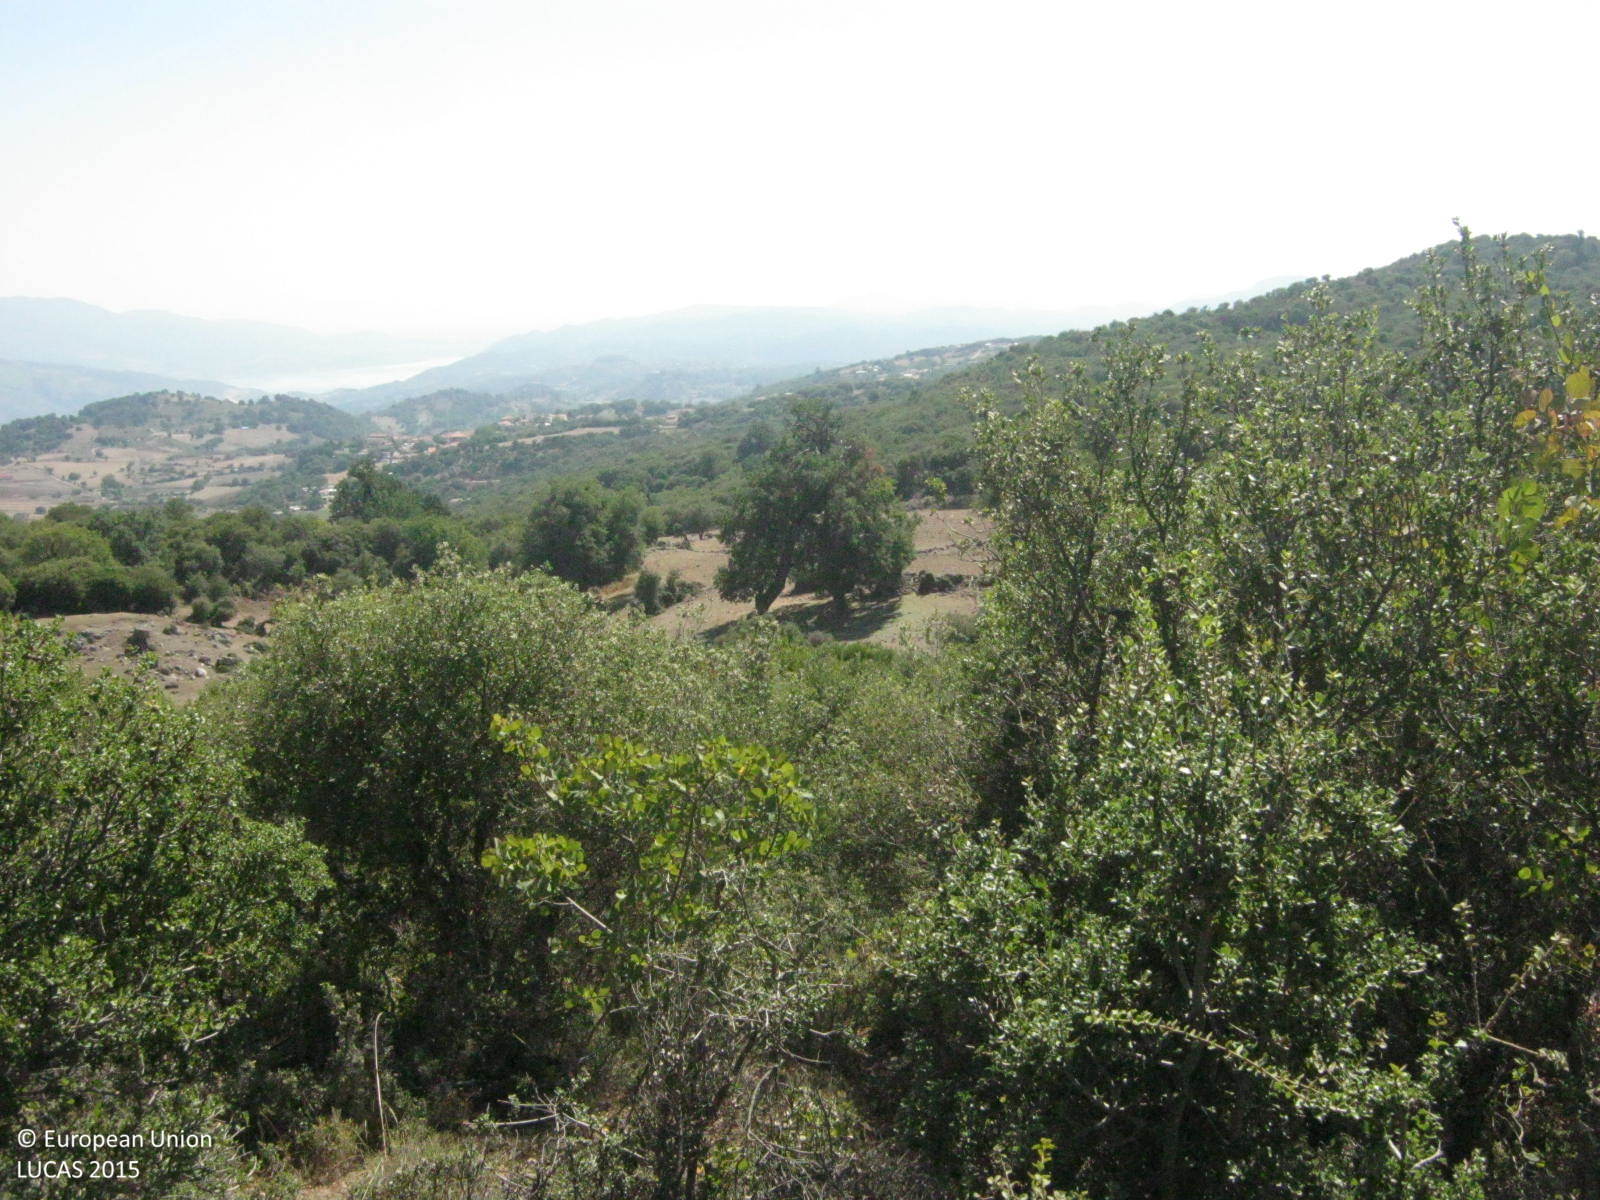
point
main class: Grassland
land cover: Grassland with sparse tree/shrub cover
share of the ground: > 75 %
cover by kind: herbaceous plants 80 %, unconsolidated bare surface 10 %, broadleaved forest trees 5 %, shrubs 5 %
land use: Agriculture (excluding fallow land and kitchen gardens)
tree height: < 5 m
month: September
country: GR
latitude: 38.8362
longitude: 21.0645
